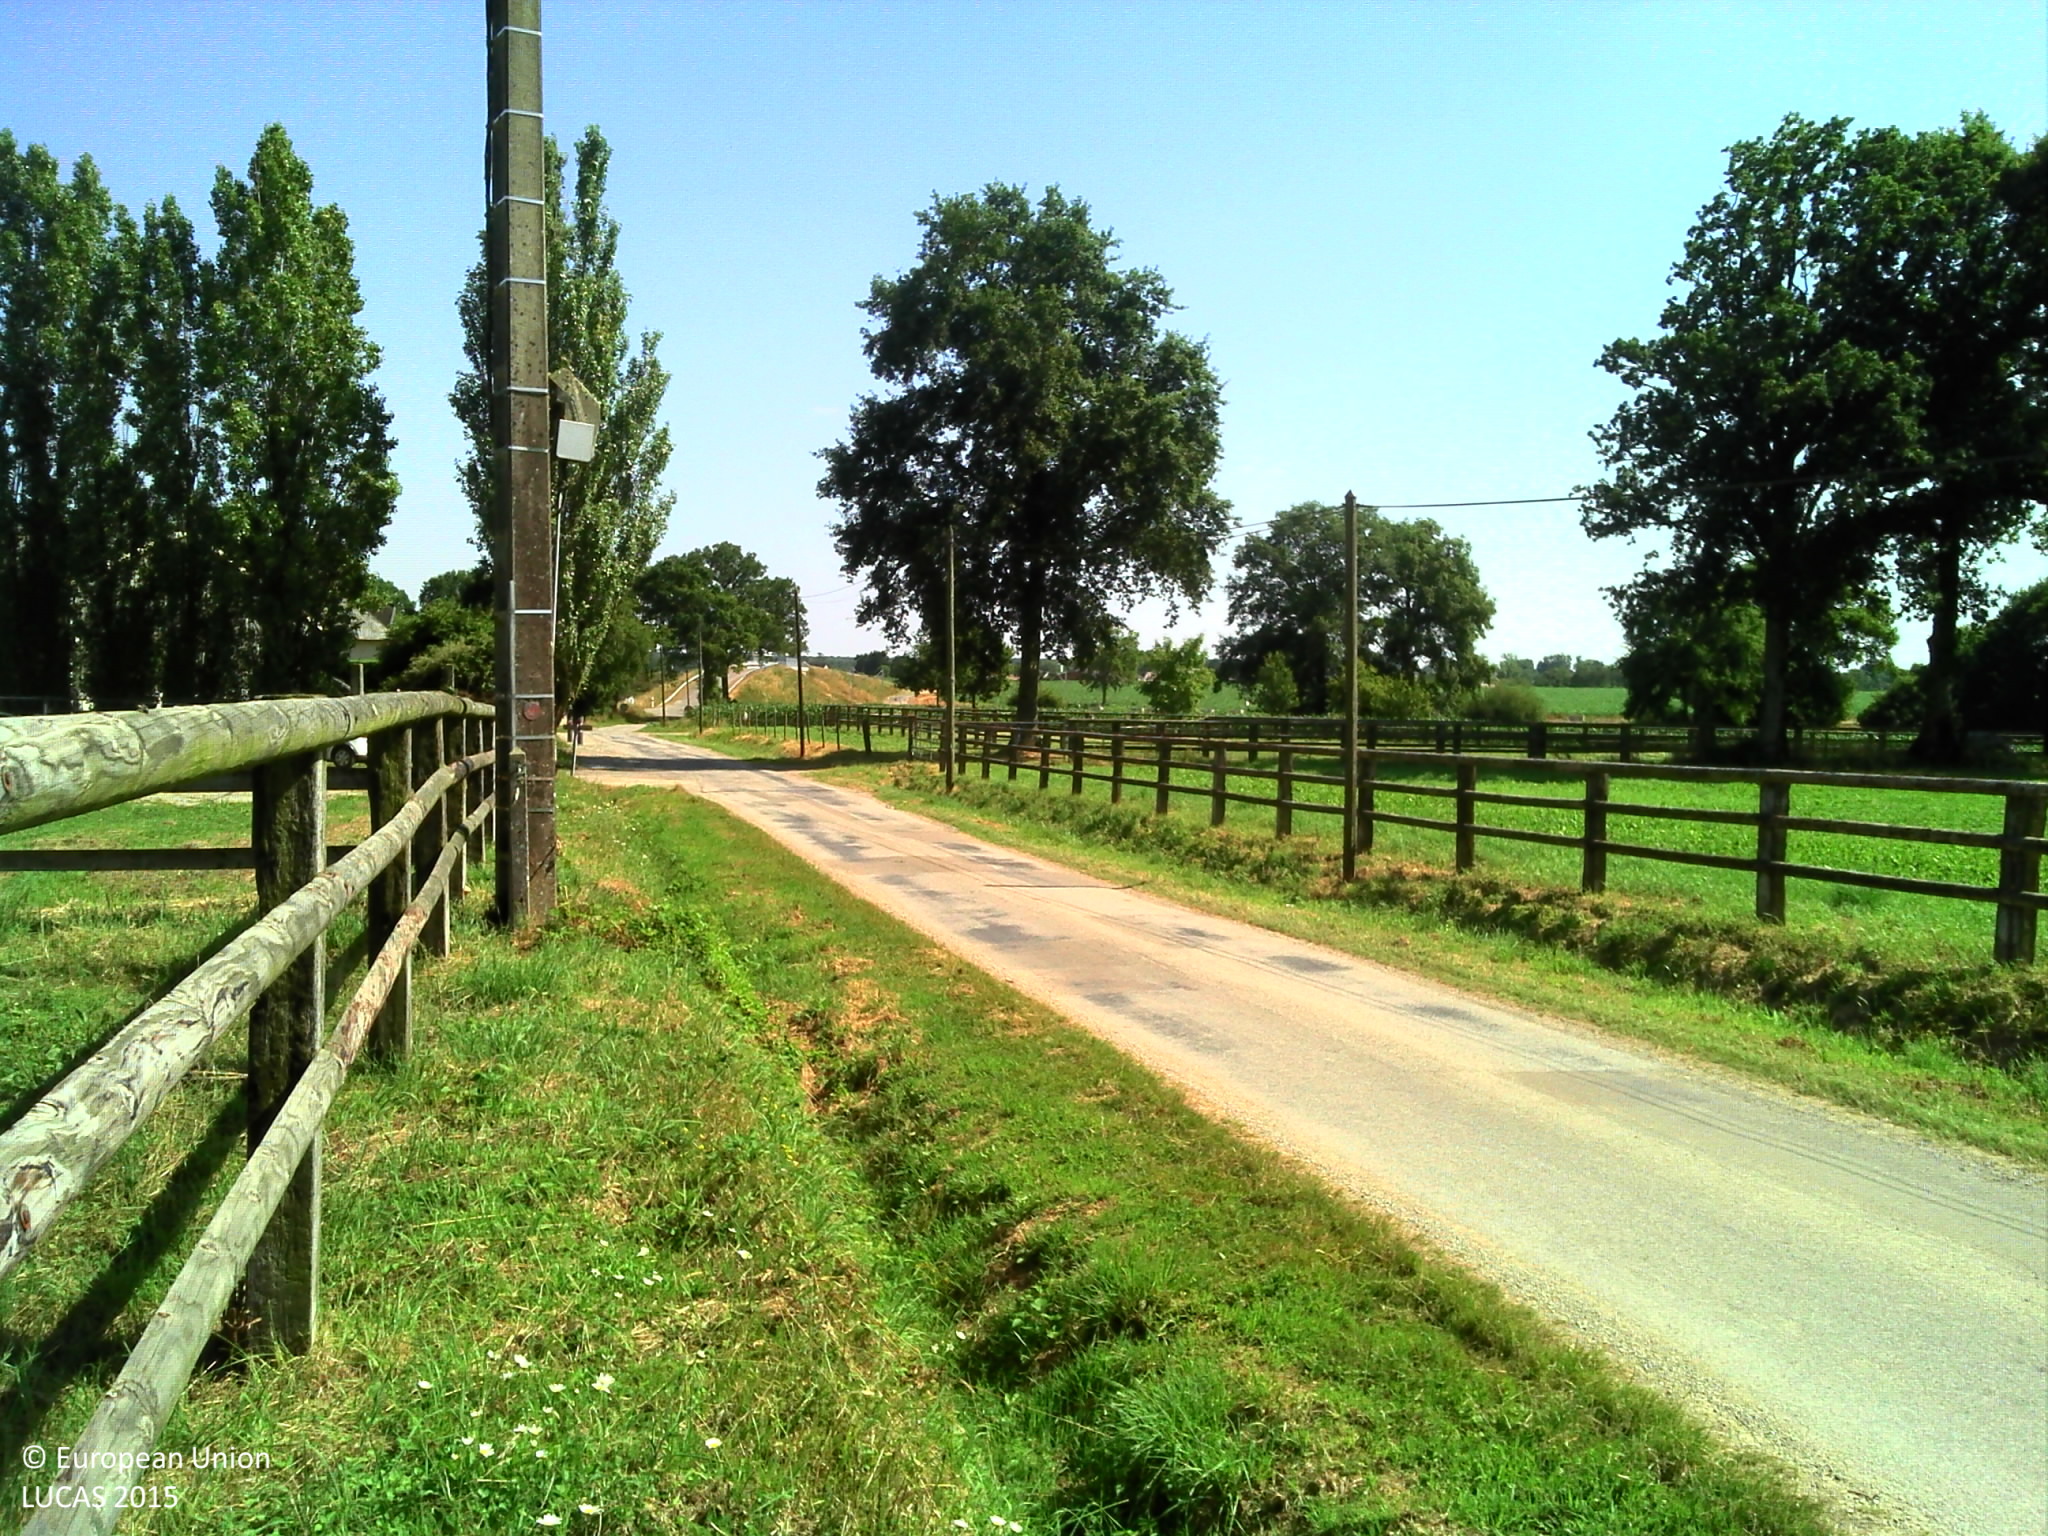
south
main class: Grassland
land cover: Grassland without tree/shrub cover
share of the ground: > 75 %
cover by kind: herbaceous plants 100 %
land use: Sport
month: July
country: FR
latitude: 48.0515
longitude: -1.1900
